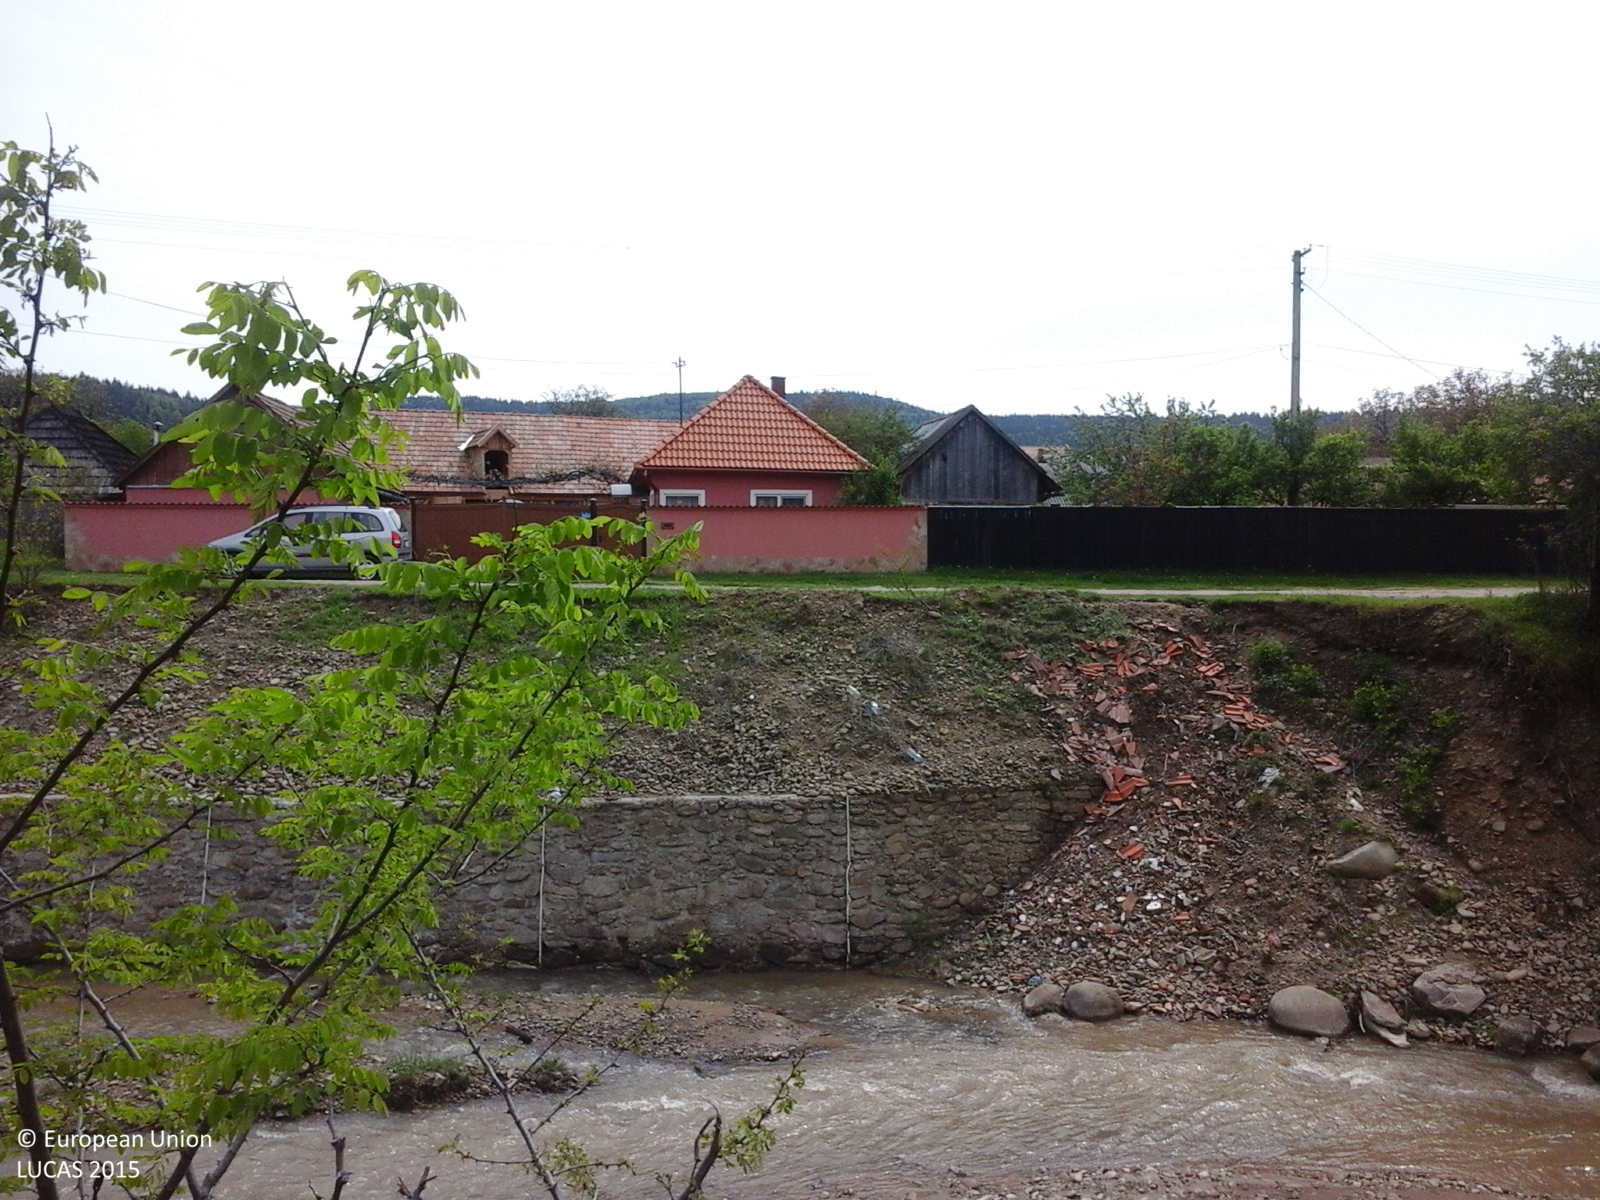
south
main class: Woodland
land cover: Broadleaved woodland
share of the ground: 50 - 75 %
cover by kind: broadleaved forest trees 100 %
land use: Residential
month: May
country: RO
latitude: 45.9449
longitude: 26.2342
